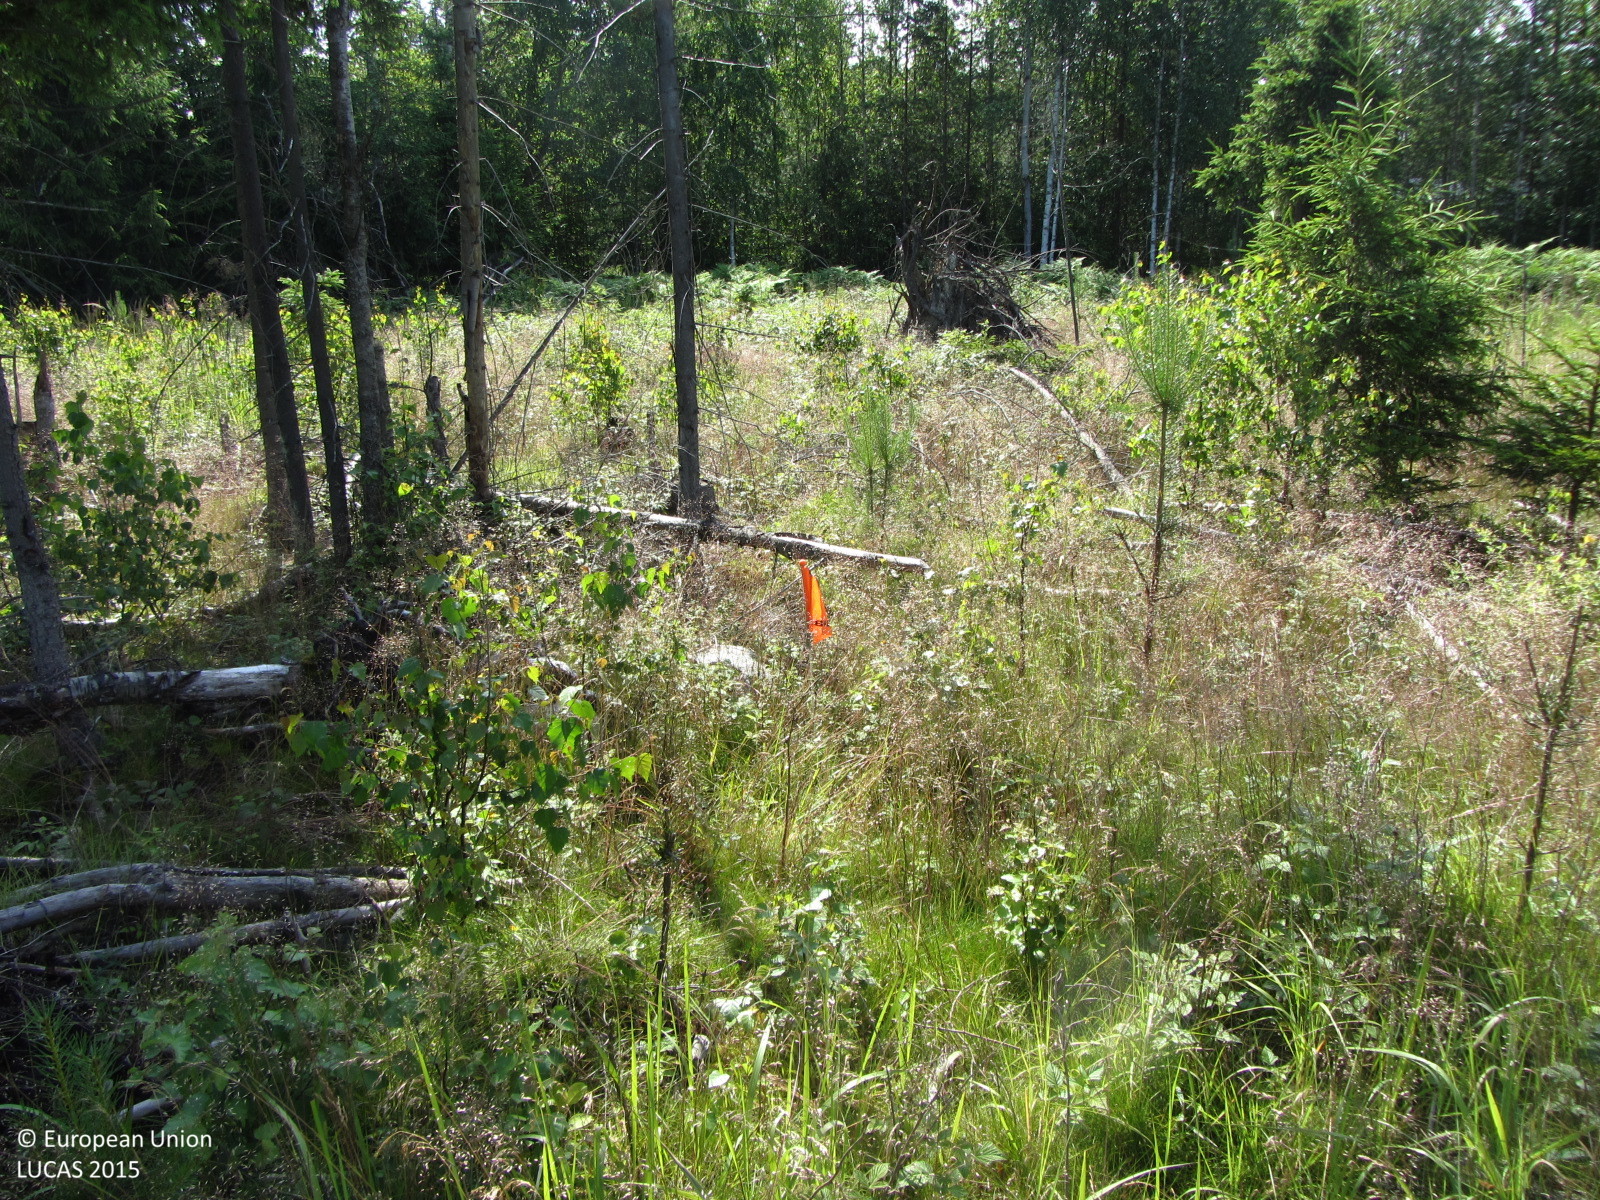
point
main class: Woodland
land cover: Spruce dominated mixed woodland
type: boreal forest
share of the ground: 25 - 50 %
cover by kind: herbaceous plants 60 %, broadleaved forest trees 15 %, shrubs 15 %, coniferous forest trees 10 %
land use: Forestry
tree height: < 5 m
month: July
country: FI
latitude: 60.0817
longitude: 24.5438
